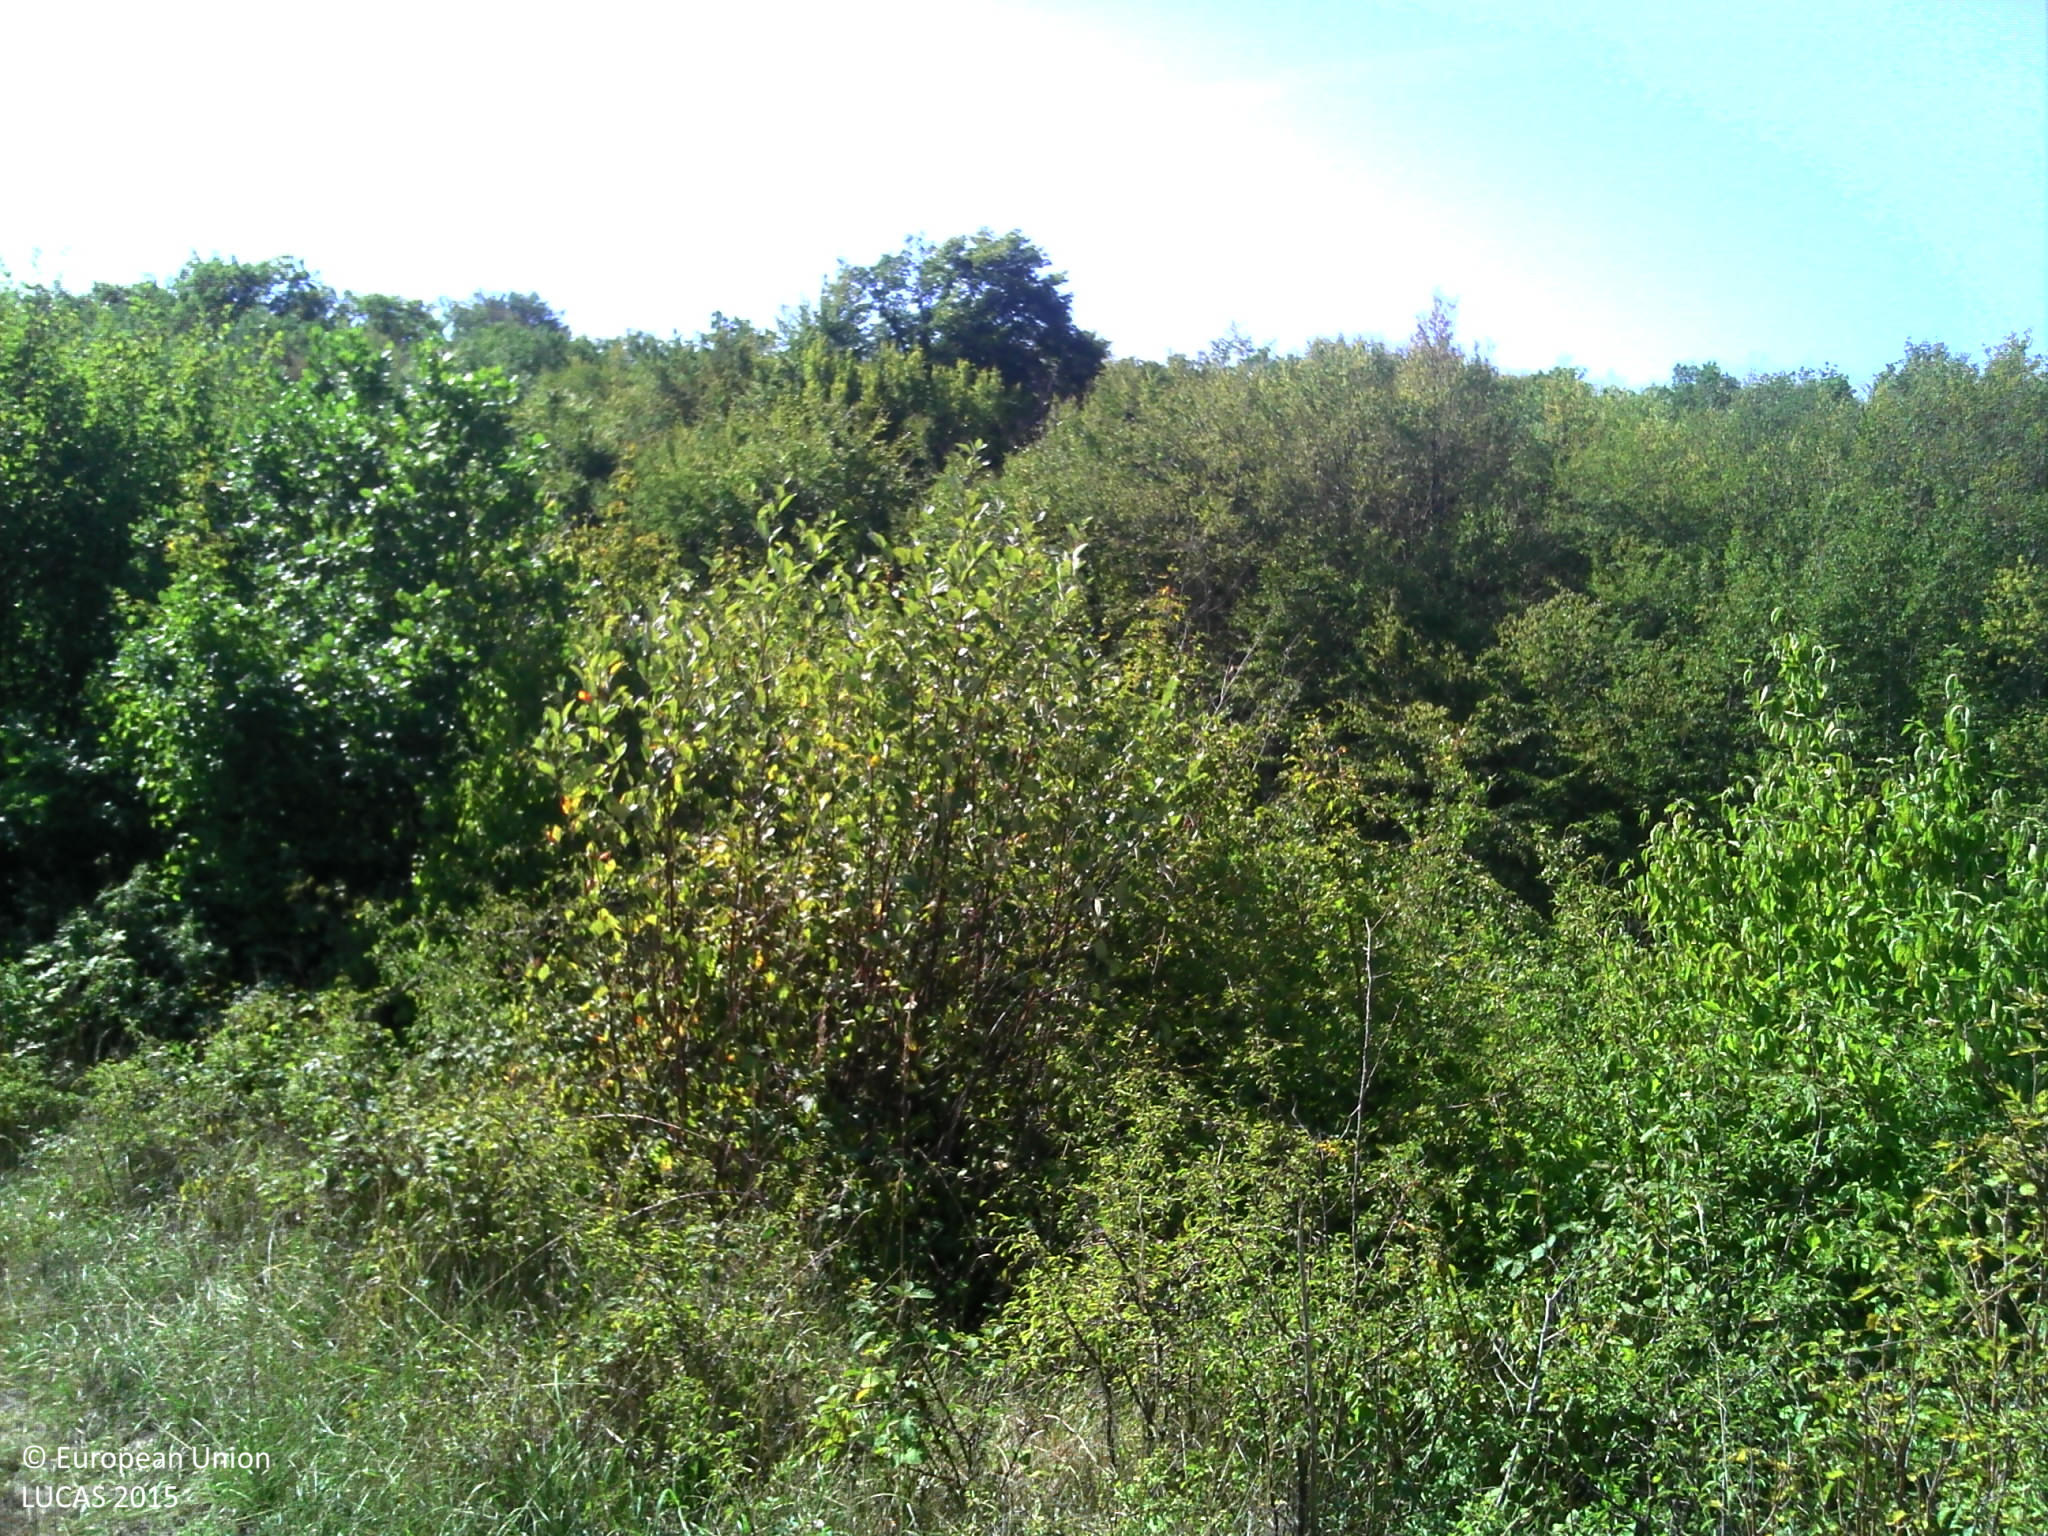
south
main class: Woodland
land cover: Broadleaved woodland
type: mesophytic deciduous forest
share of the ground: > 75 %
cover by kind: broadleaved forest trees 70 %, herbaceous plants 20 %, shrubs 10 %
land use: Semi-natural and natural areas not in use
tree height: < 5 m
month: August
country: FR
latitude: 47.2369
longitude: 4.8354
